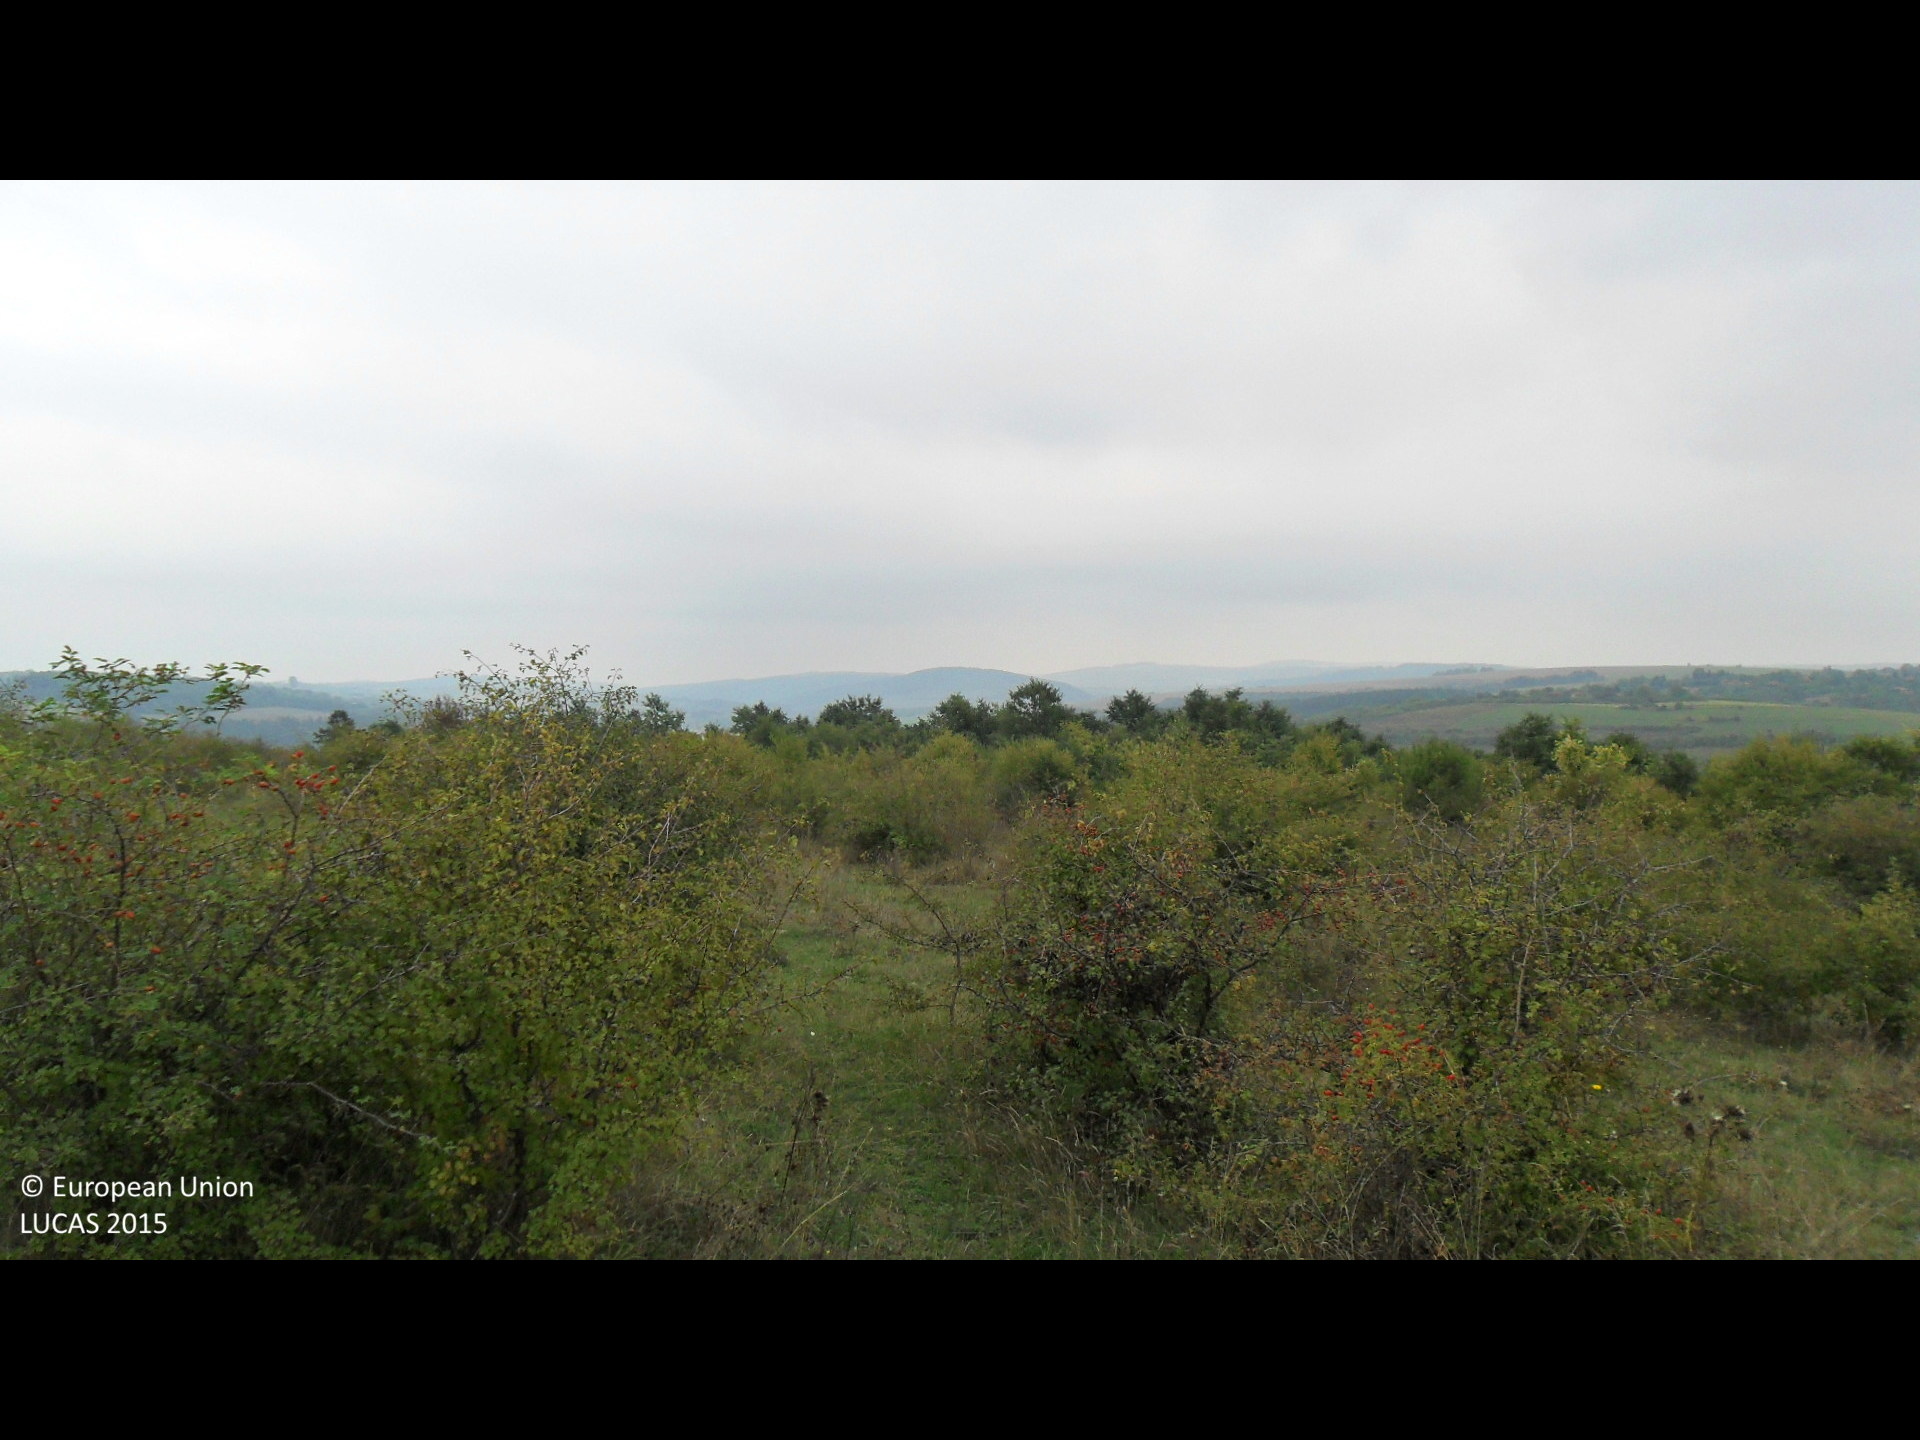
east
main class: Grassland
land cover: Grassland with sparse tree/shrub cover
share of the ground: > 75 %
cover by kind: herbaceous plants 90 %, broadleaved forest trees 5 %, shrubs 5 %
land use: Agriculture (excluding fallow land and kitchen gardens)
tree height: < 5 m
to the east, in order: Grassland with sparse tree/shrub cover; Shrubland with sparse tree cover; Lines of trees; Tracks; Broadleaved woodland; Grassland with sparse tree/shrub cover; Shrubland with sparse tree cover
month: September
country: BG
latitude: 43.1273
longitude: 26.2837
